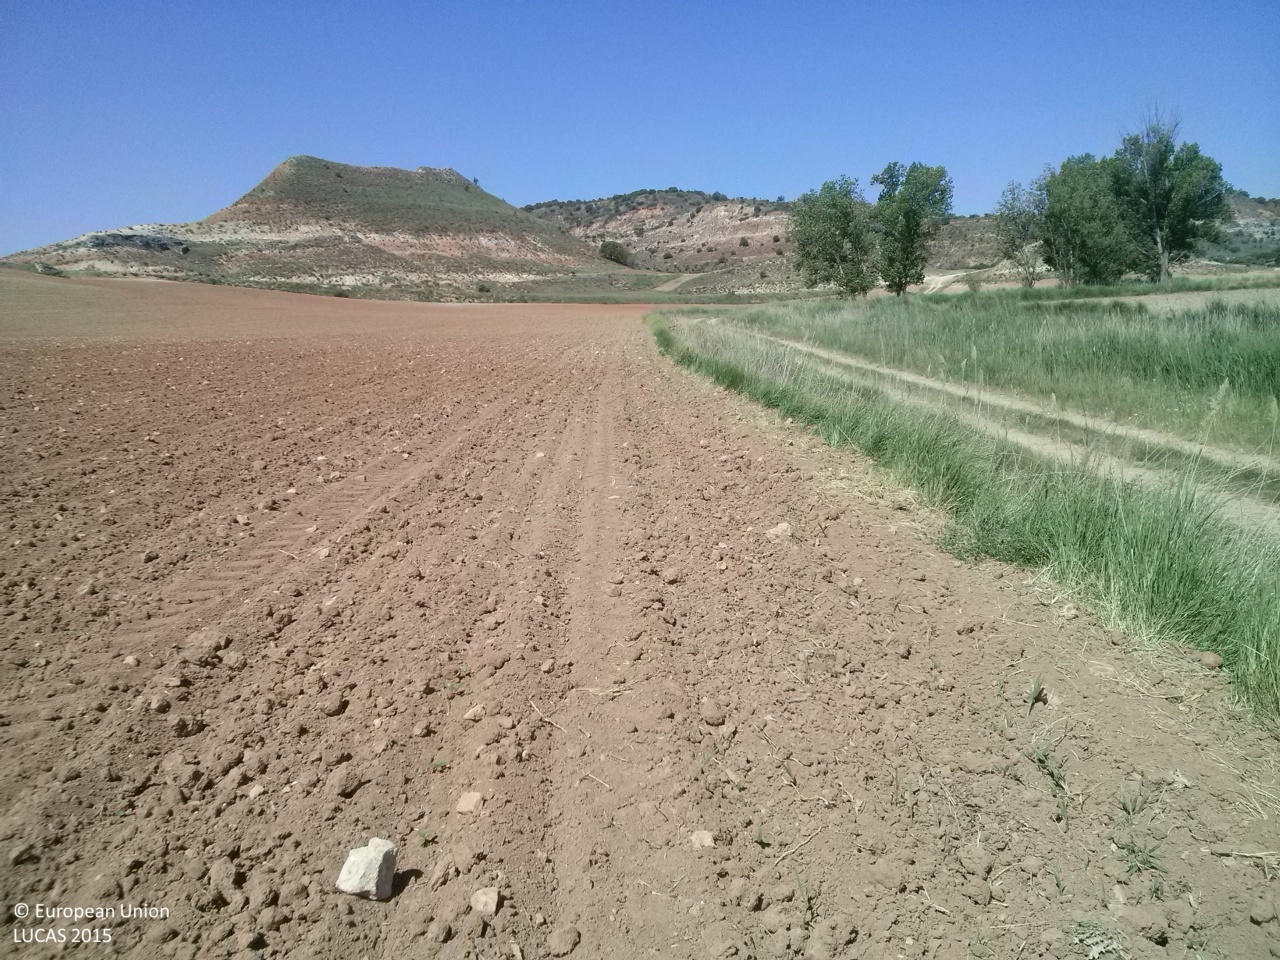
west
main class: Cropland
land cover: Sunflower
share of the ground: < 10 %
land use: Agriculture (excluding fallow land and kitchen gardens)
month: May
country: ES
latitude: 40.1681
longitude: -2.5735
